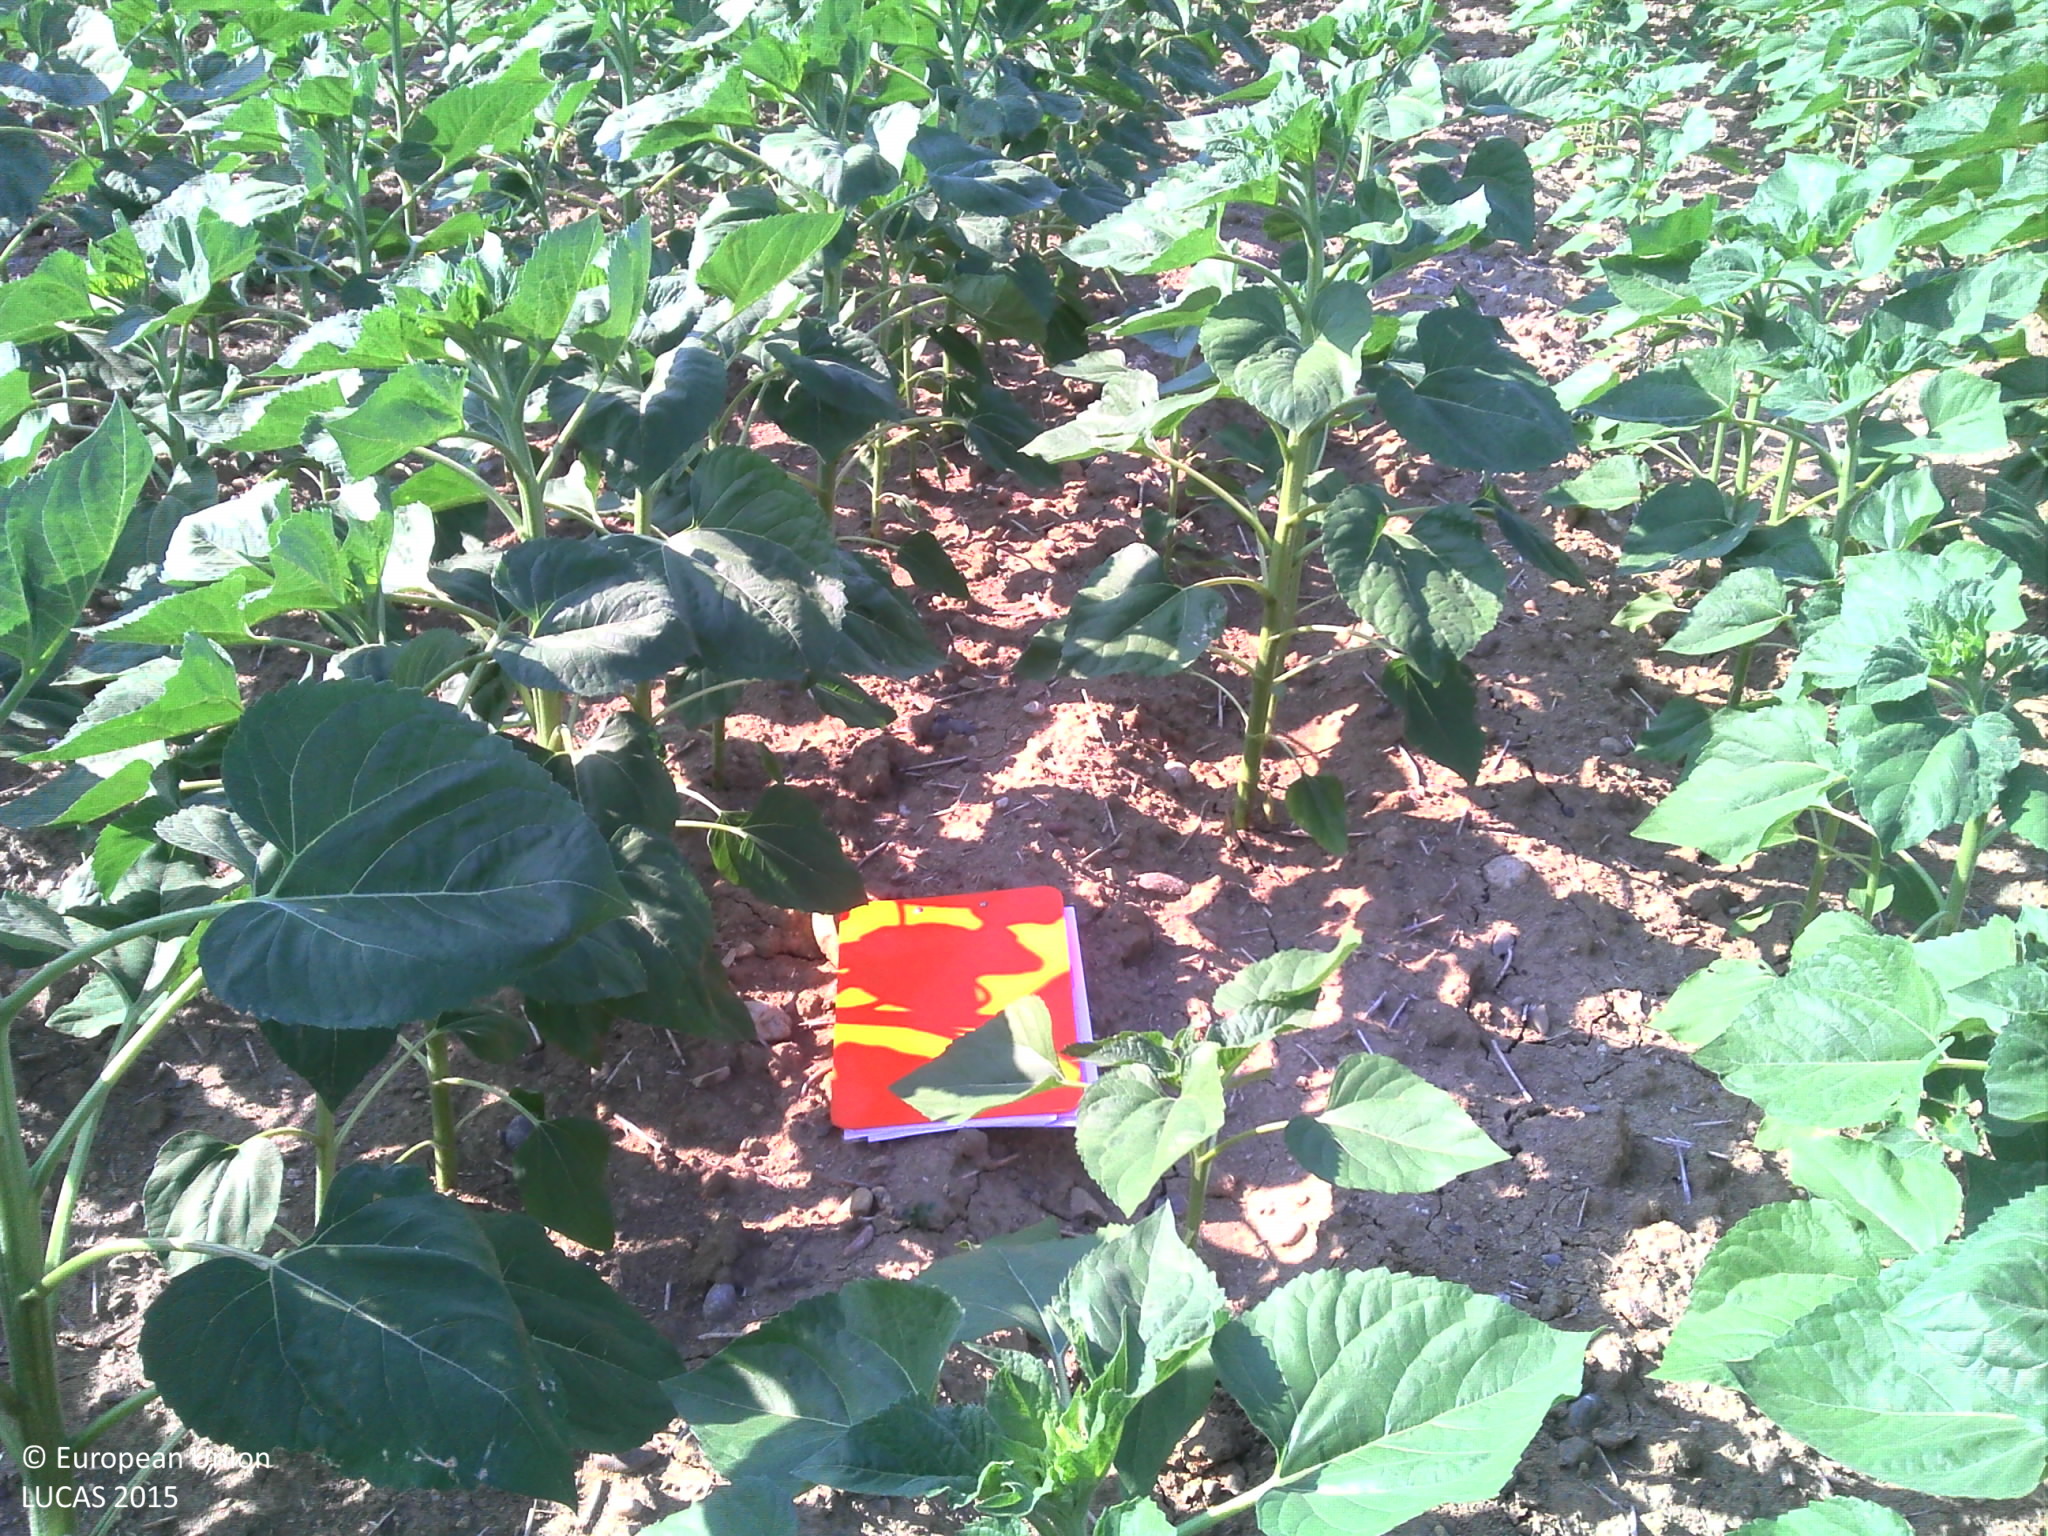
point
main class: Cropland
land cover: Sunflower
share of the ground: > 75 %
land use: Agriculture (excluding fallow land and kitchen gardens)
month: June
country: FR
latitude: 43.1572
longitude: 2.0505
